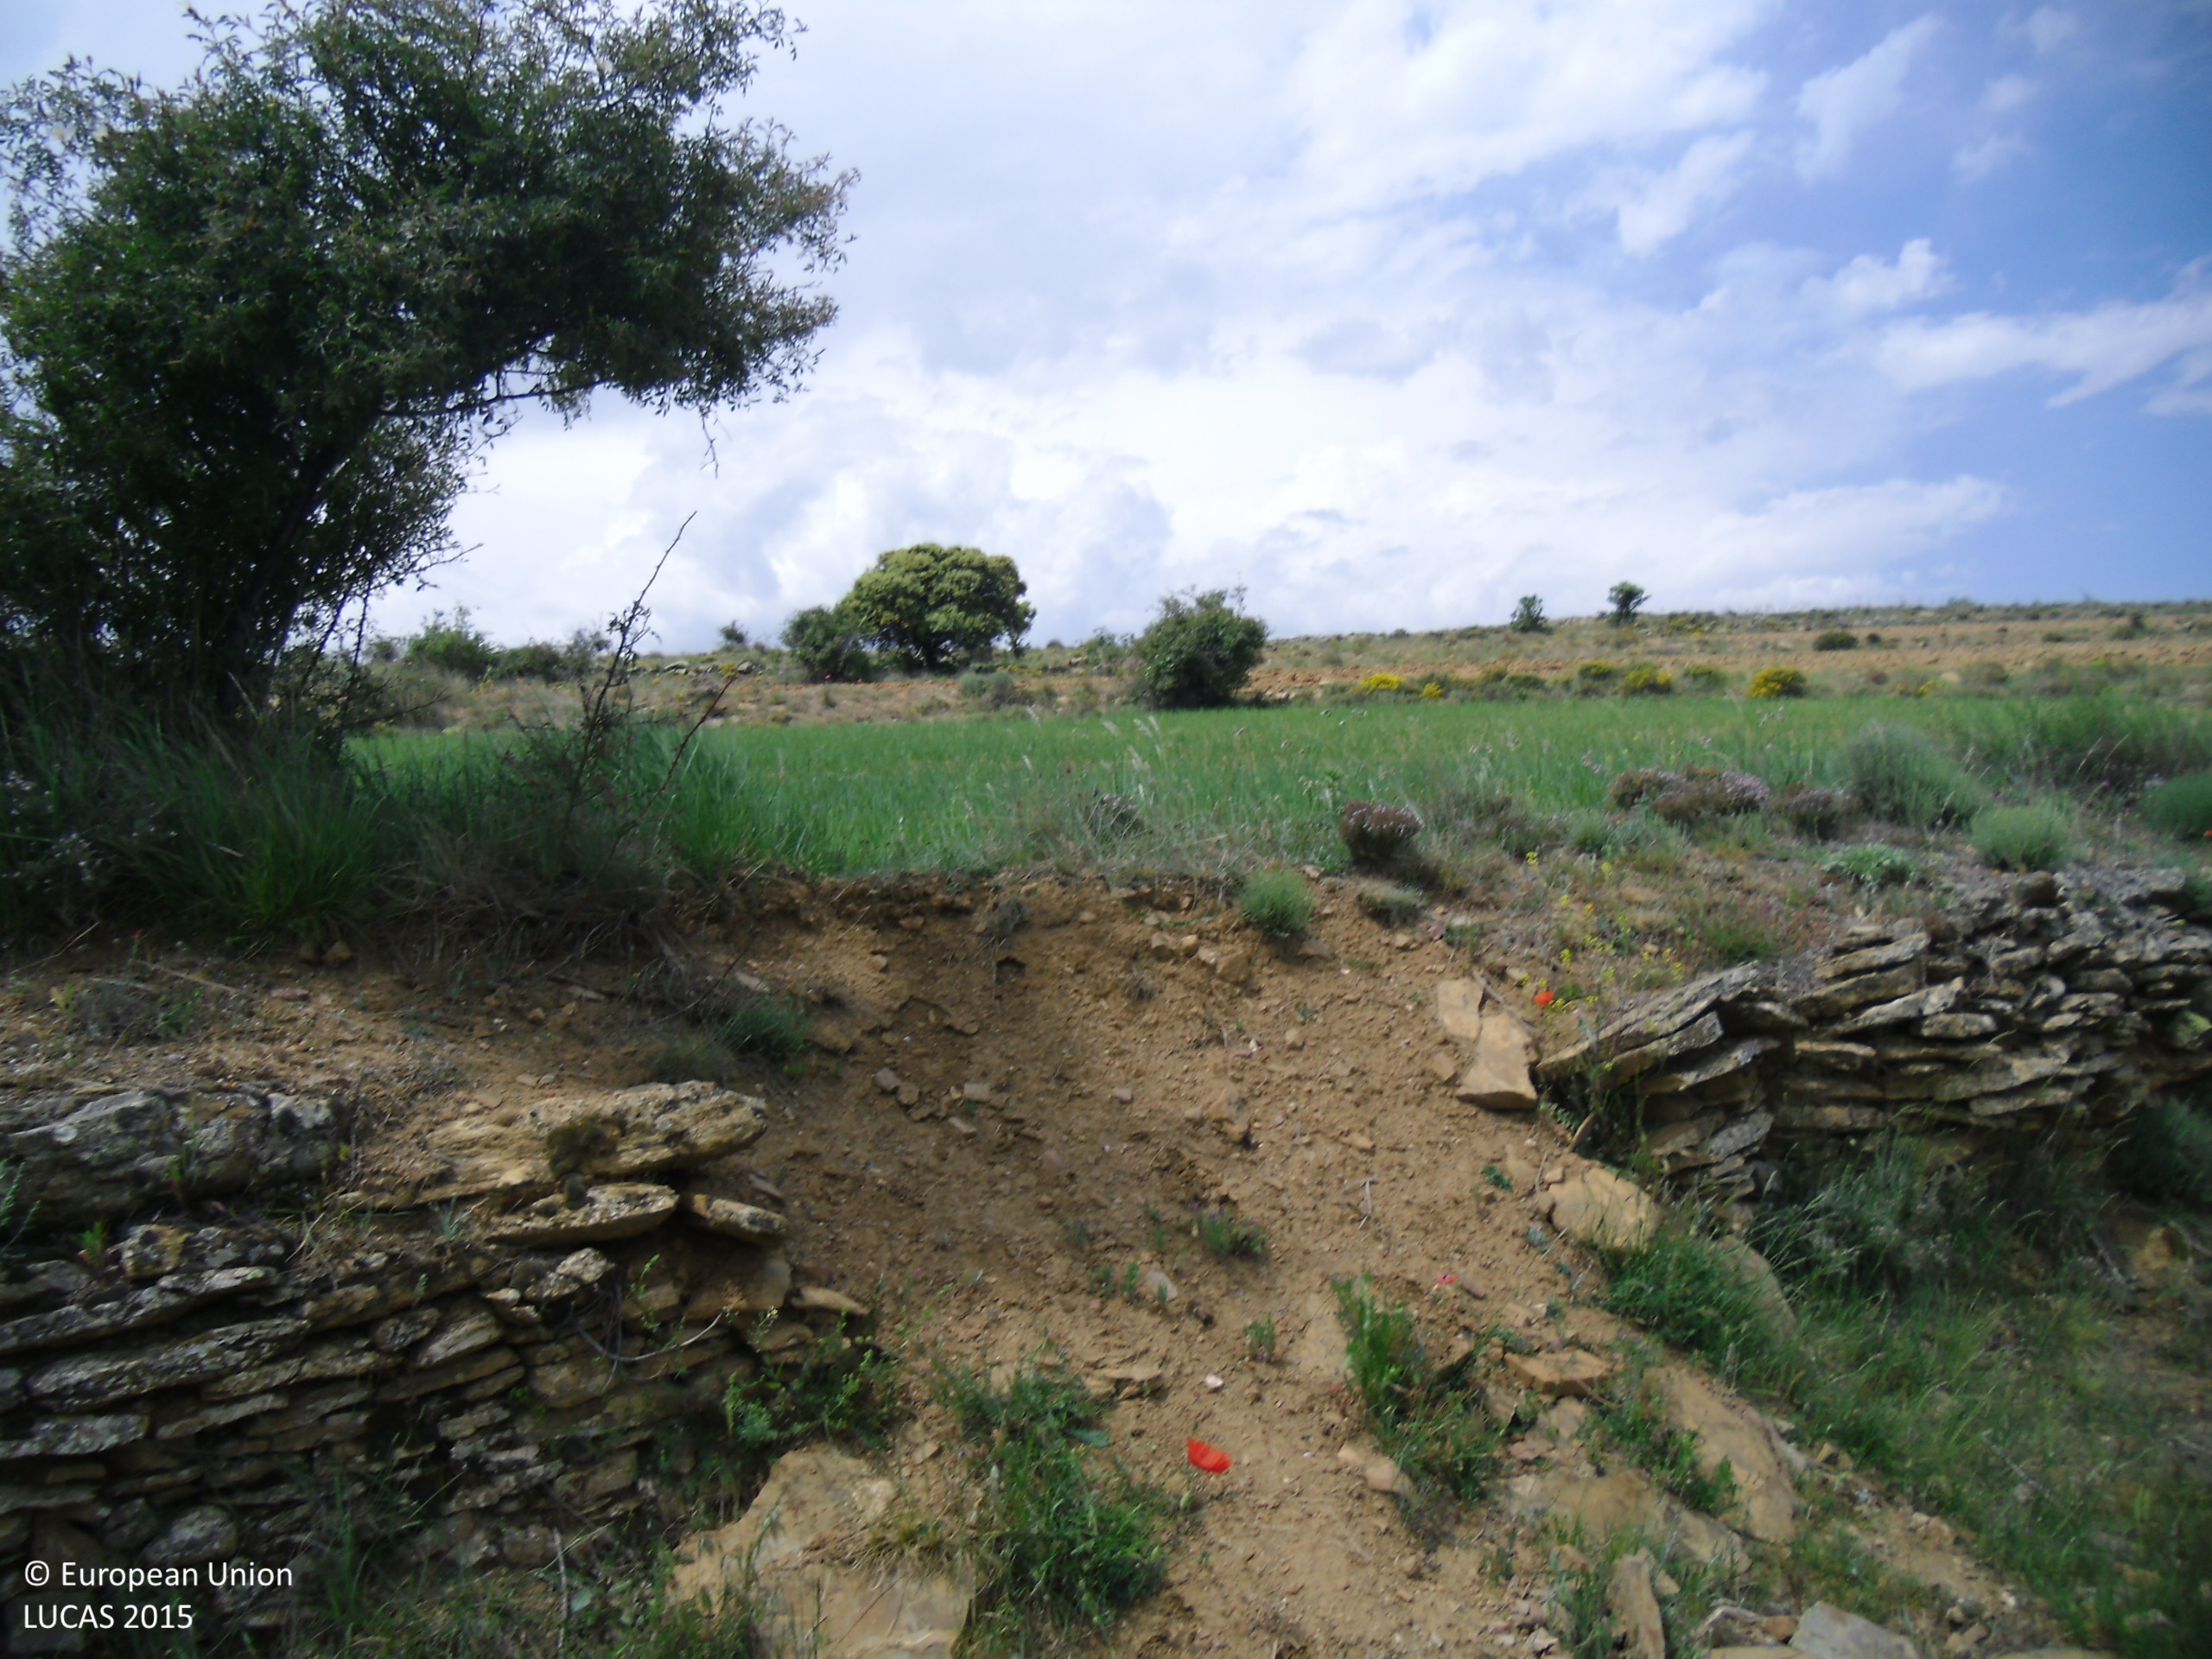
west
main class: Cropland
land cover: Barley
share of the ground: > 75 %
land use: Agriculture (excluding fallow land and kitchen gardens)
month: May
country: ES
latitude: 40.8880
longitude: -0.8263
